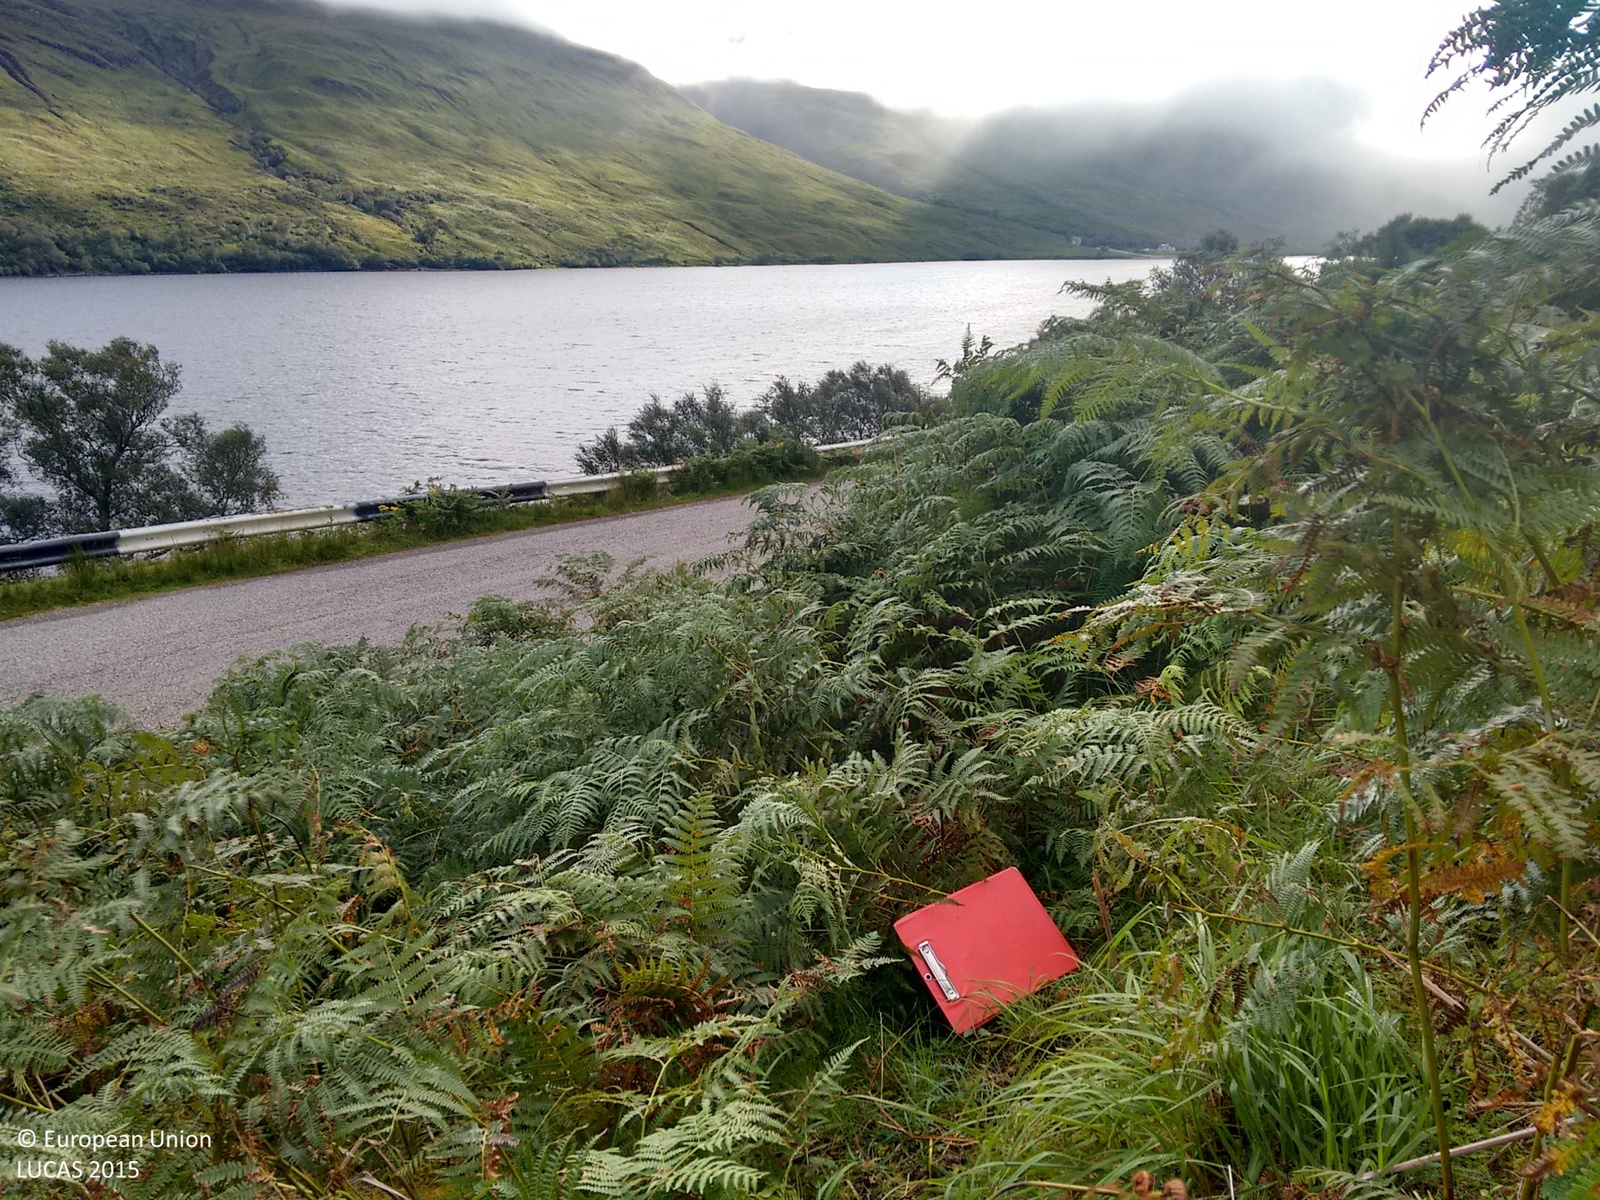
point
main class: Grassland
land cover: Grassland with sparse tree/shrub cover
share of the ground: > 75 %
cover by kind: herbaceous plants 85 %, shrubs 10 %, broadleaved forest trees 5 %
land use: Semi-natural and natural areas not in use
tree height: > 5 m
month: September
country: GB
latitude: 58.2869
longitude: -4.8477
